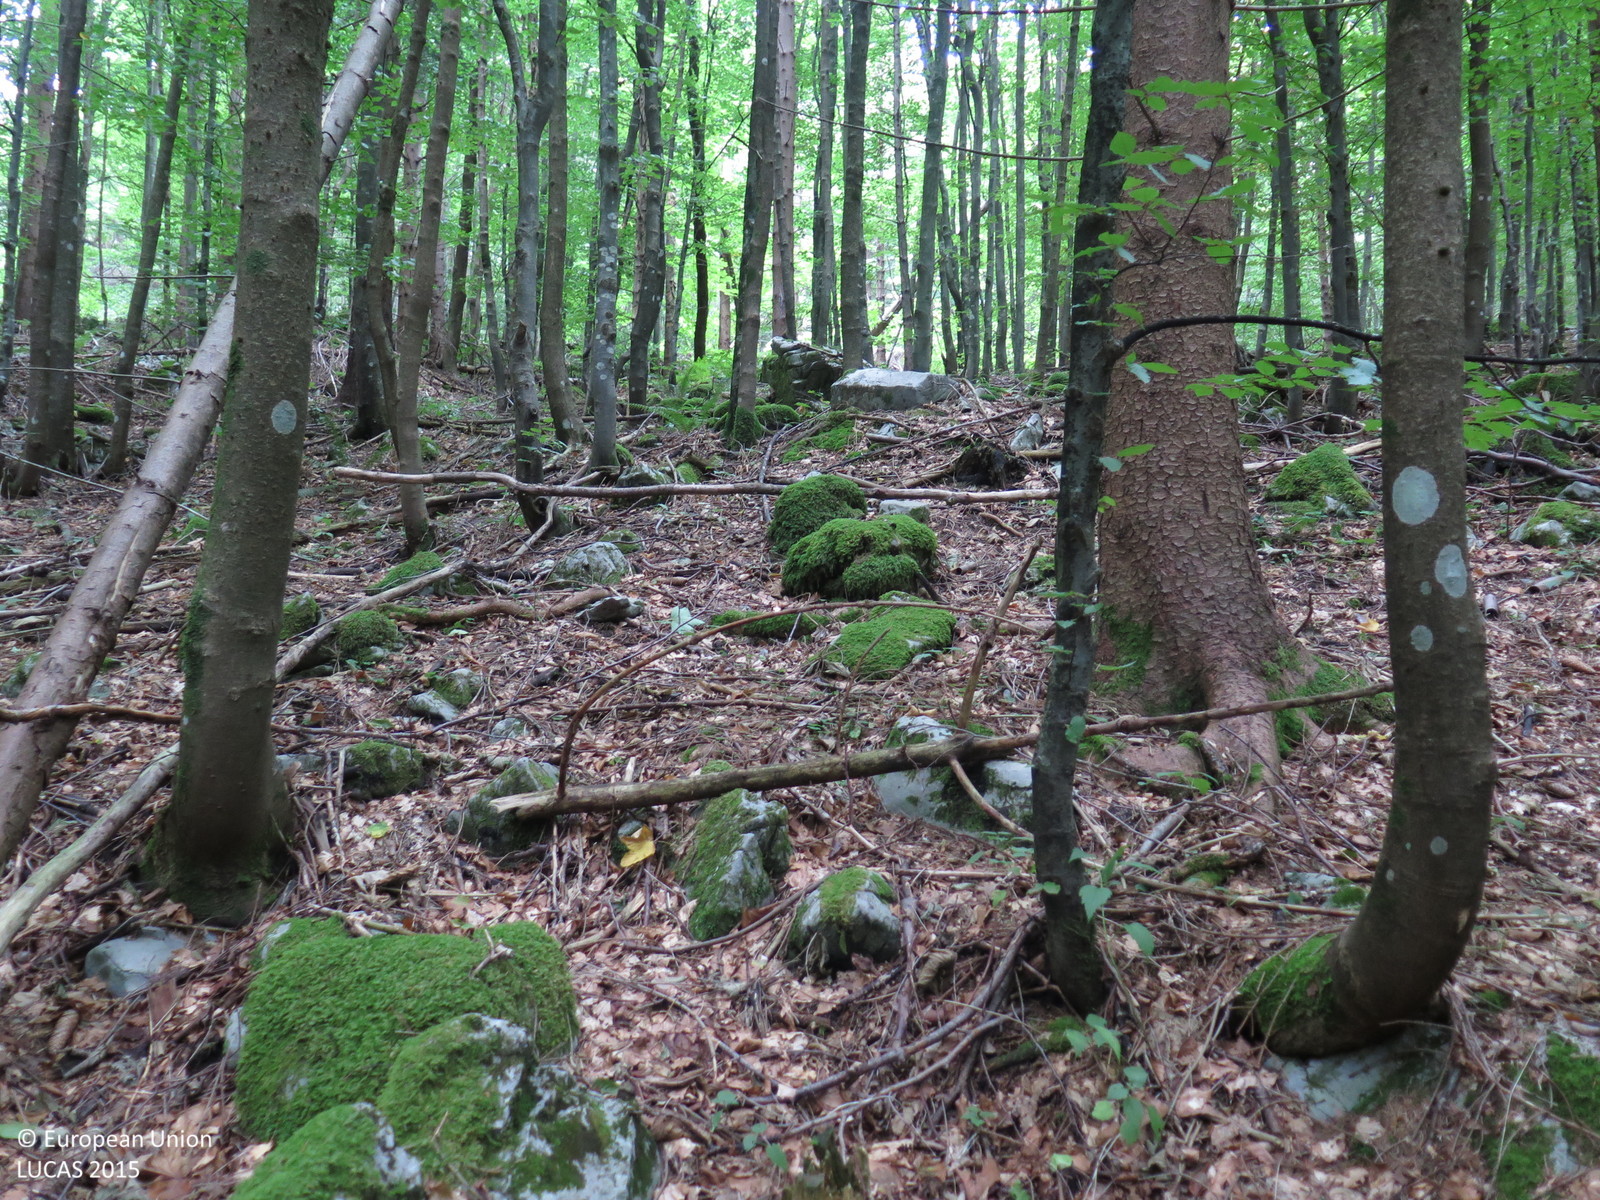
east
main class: Woodland
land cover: Other mixed woodland
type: mountainous beech forest
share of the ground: > 75 %
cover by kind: broadleaved forest trees 75 %, coniferous forest trees 25 %
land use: Forestry
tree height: > 5 m
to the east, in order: Other mixed woodland; Tracks; Other mixed woodland; Tracks; Other mixed woodland
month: August
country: HR
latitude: 45.1180
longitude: 14.9396
